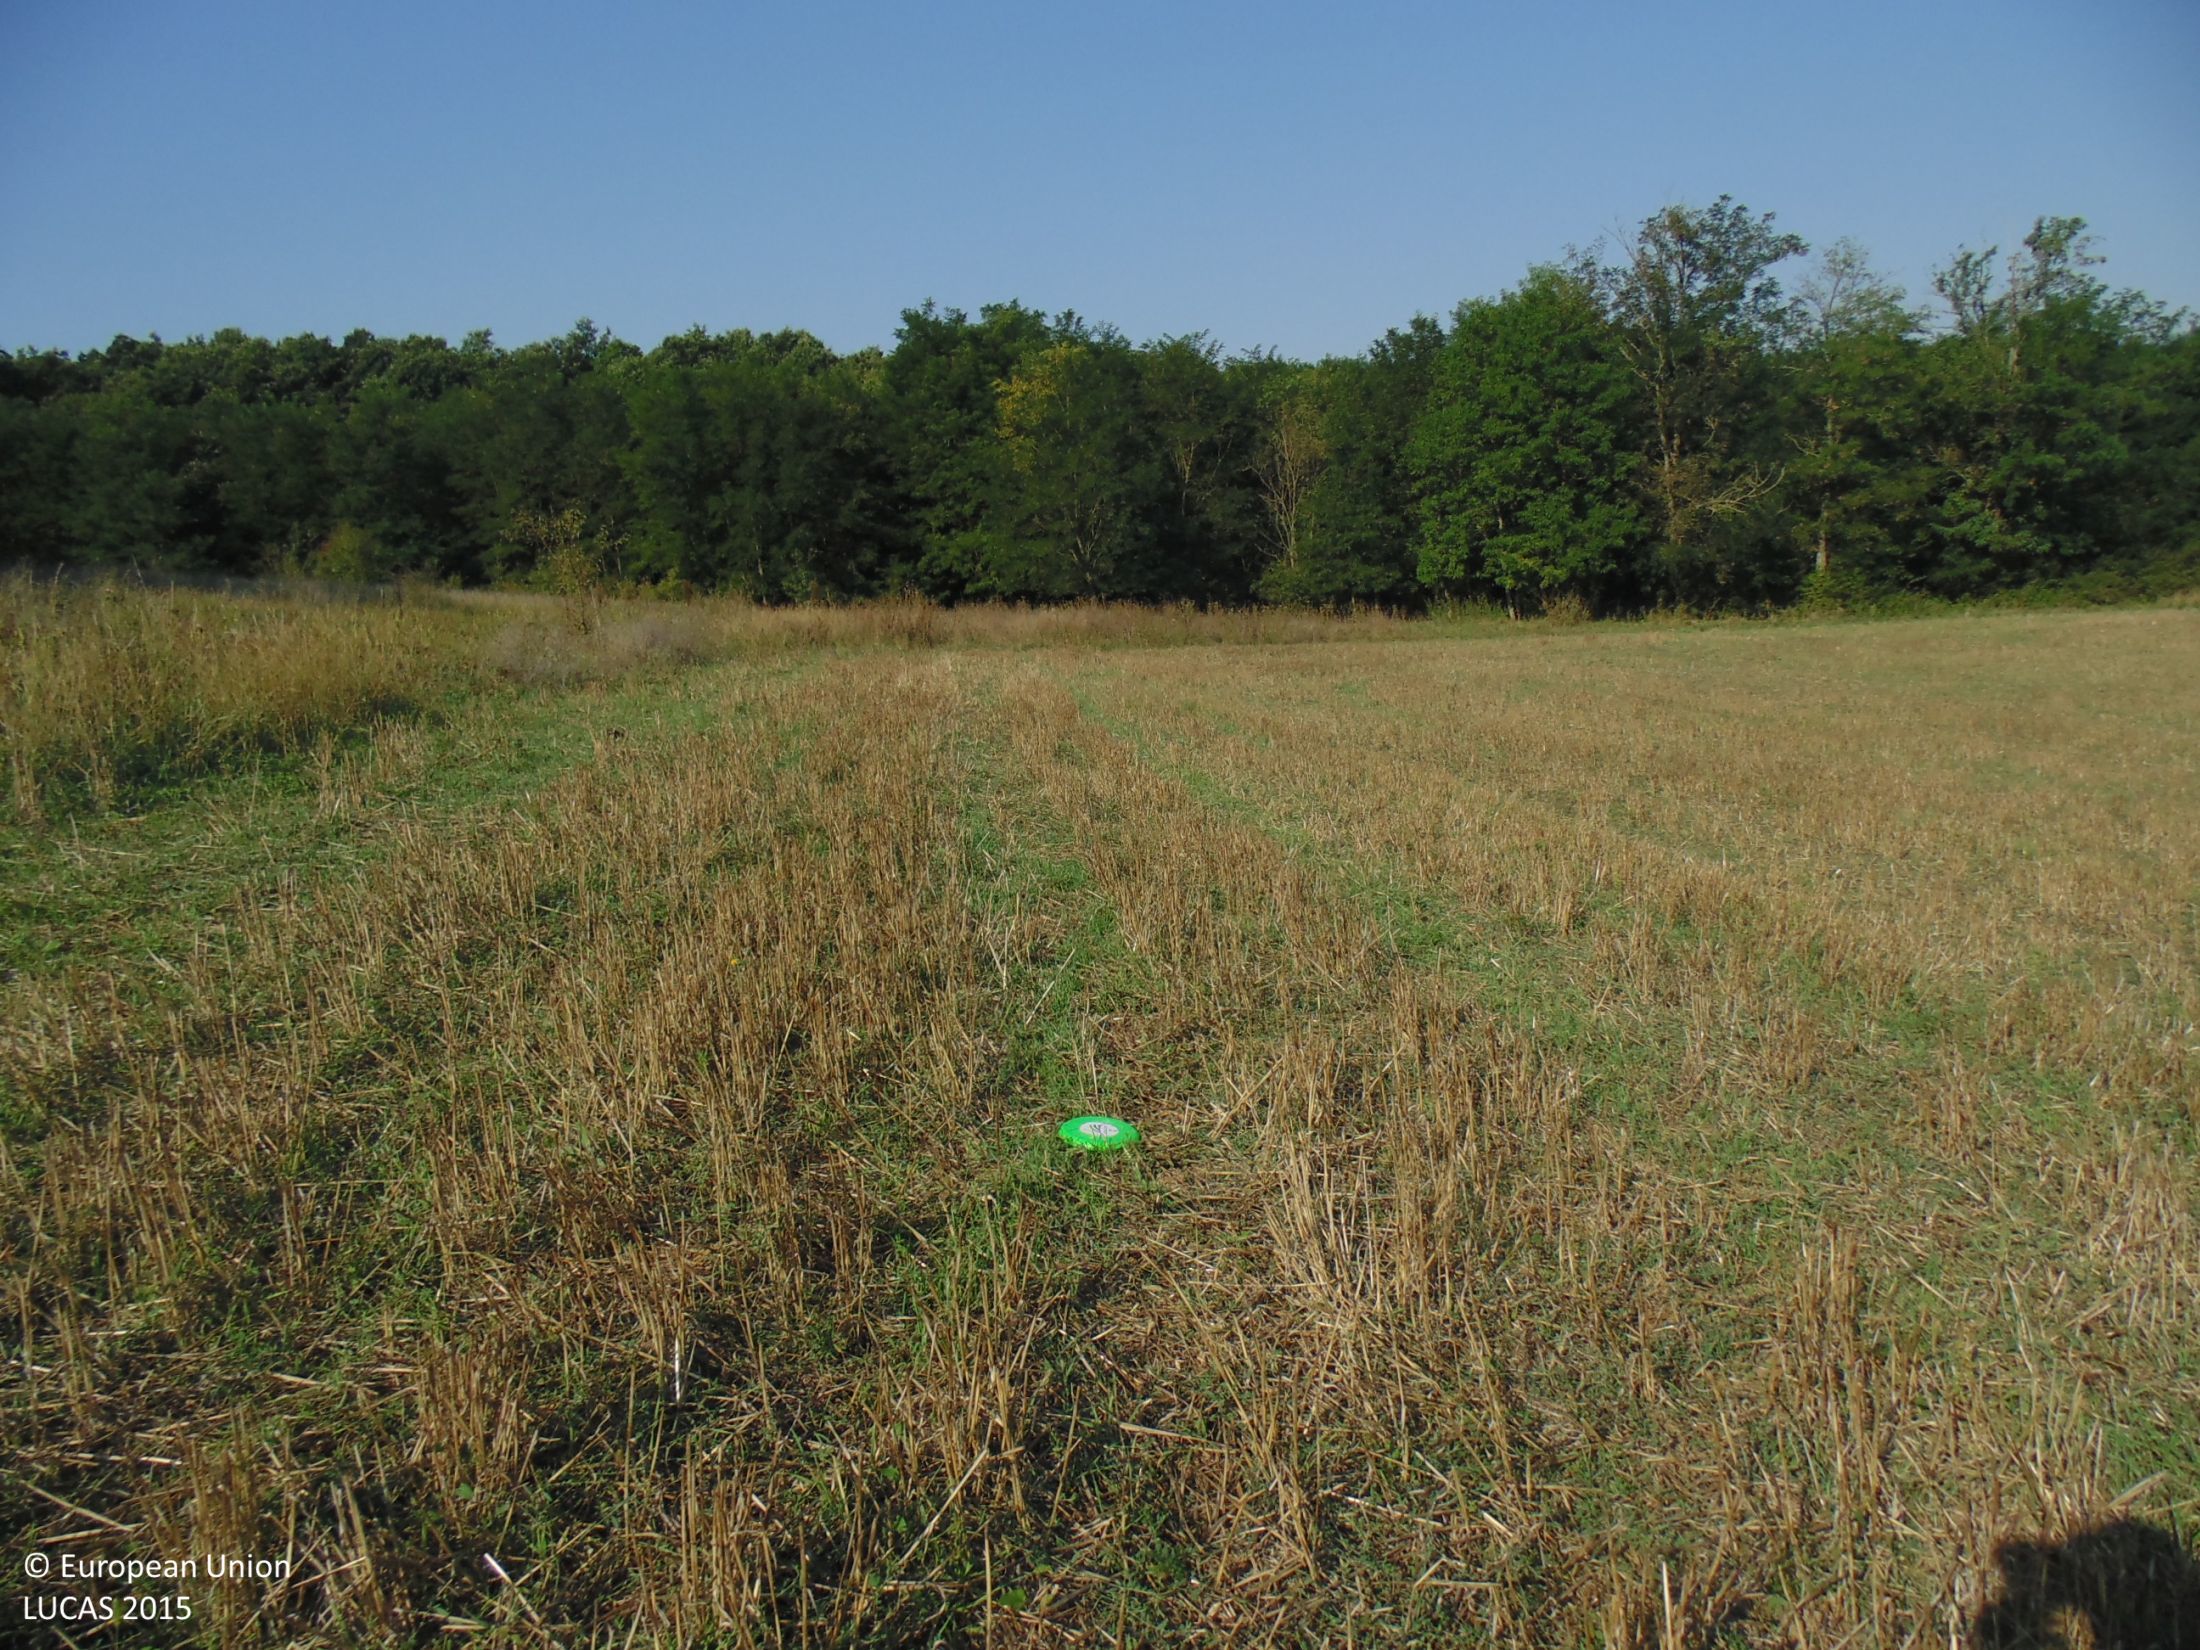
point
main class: Cropland
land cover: Common wheat
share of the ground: 25 - 50 %
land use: Agriculture (excluding fallow land and kitchen gardens)
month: September
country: BG
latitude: 43.7549
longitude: 27.0500
